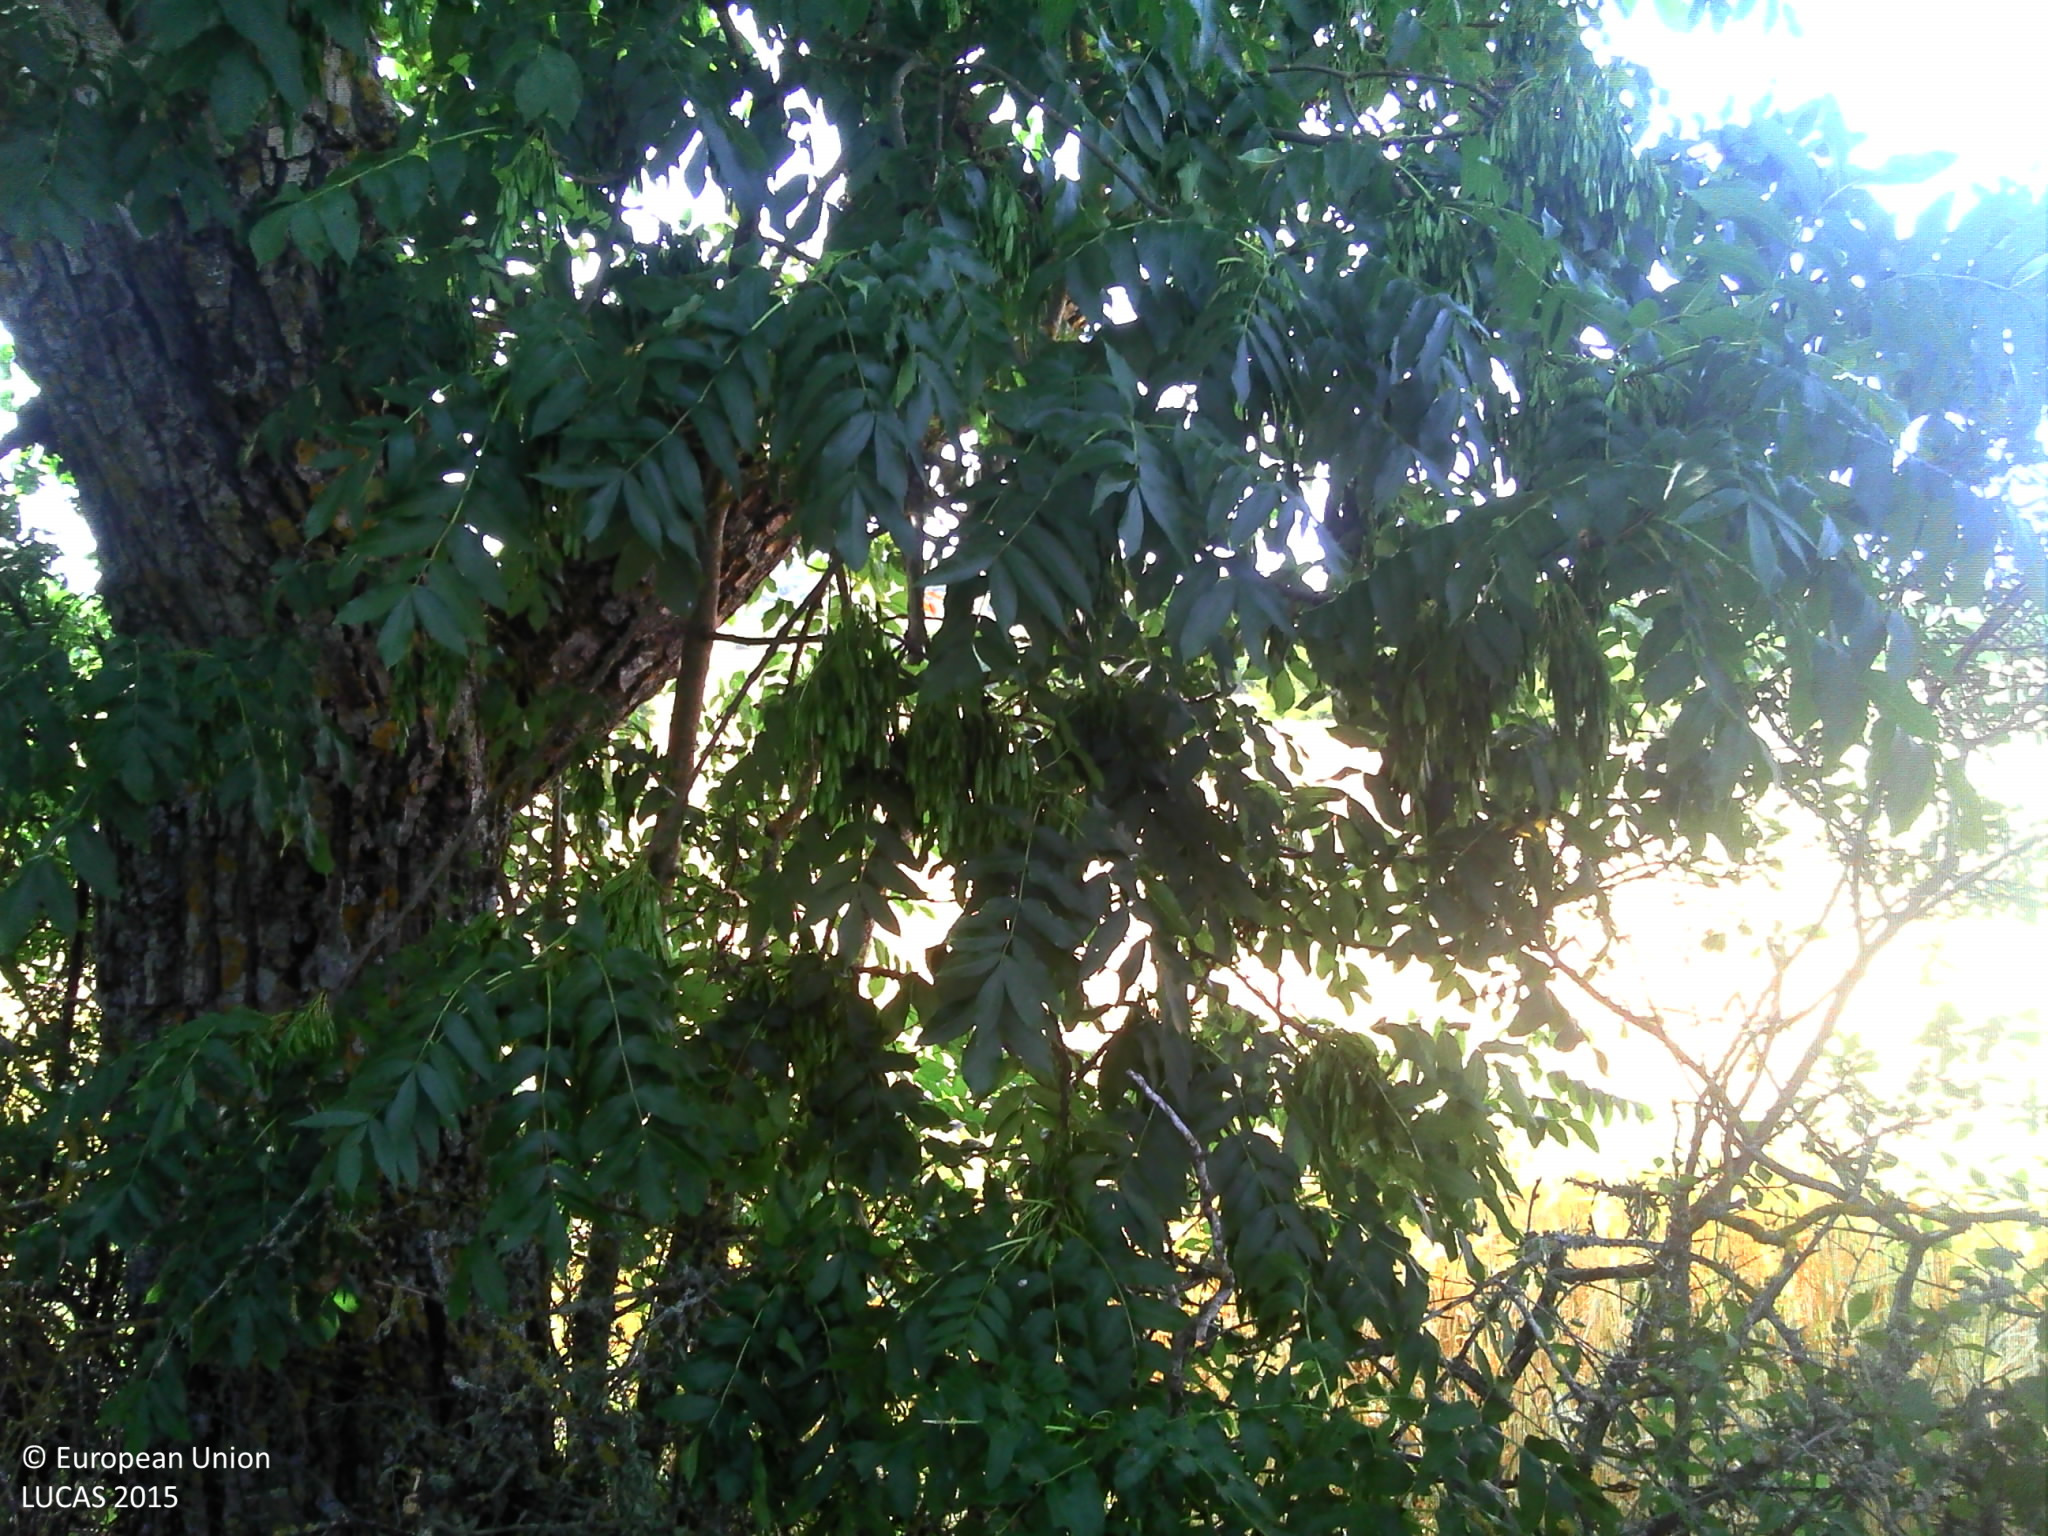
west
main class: Woodland
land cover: Pine dominated coniferous woodland
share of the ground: > 75 %
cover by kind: coniferous forest trees 95 %, broadleaved forest trees 5 %
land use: Agriculture (excluding fallow land and kitchen gardens)
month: July
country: FR
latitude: 44.3618
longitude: 3.4685
